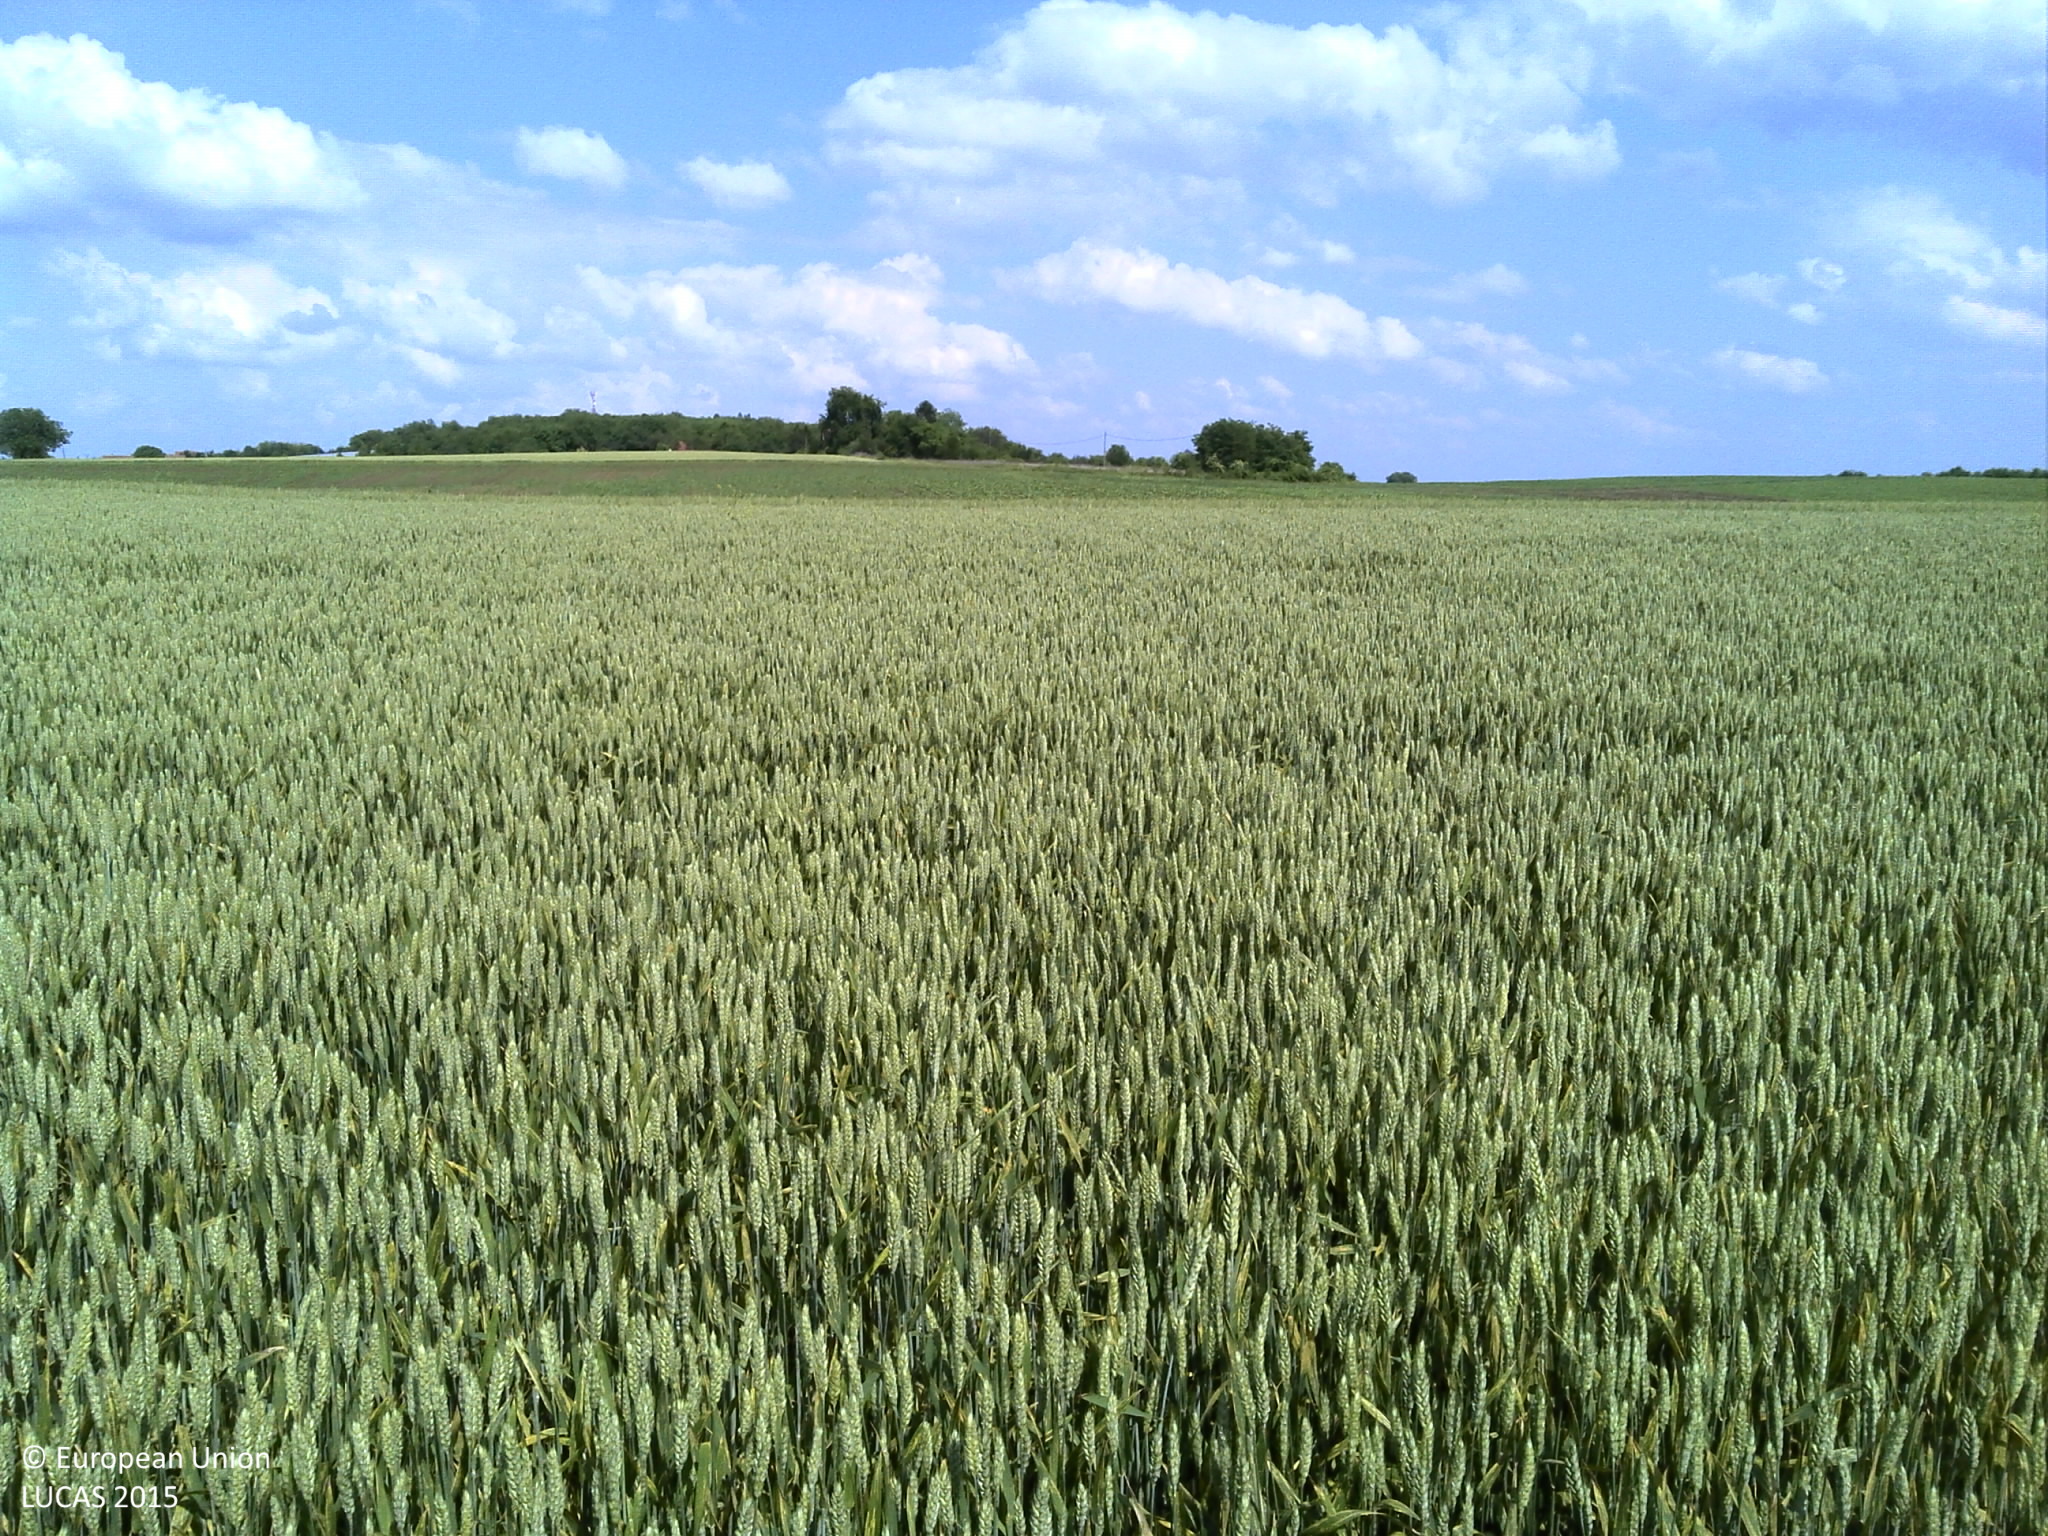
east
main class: Cropland
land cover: Common wheat
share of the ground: > 75 %
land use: Agriculture (excluding fallow land and kitchen gardens)
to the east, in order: Common wheat; Barley; Tracks; Sugar beet
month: May
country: HR
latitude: 45.5217
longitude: 18.9583
